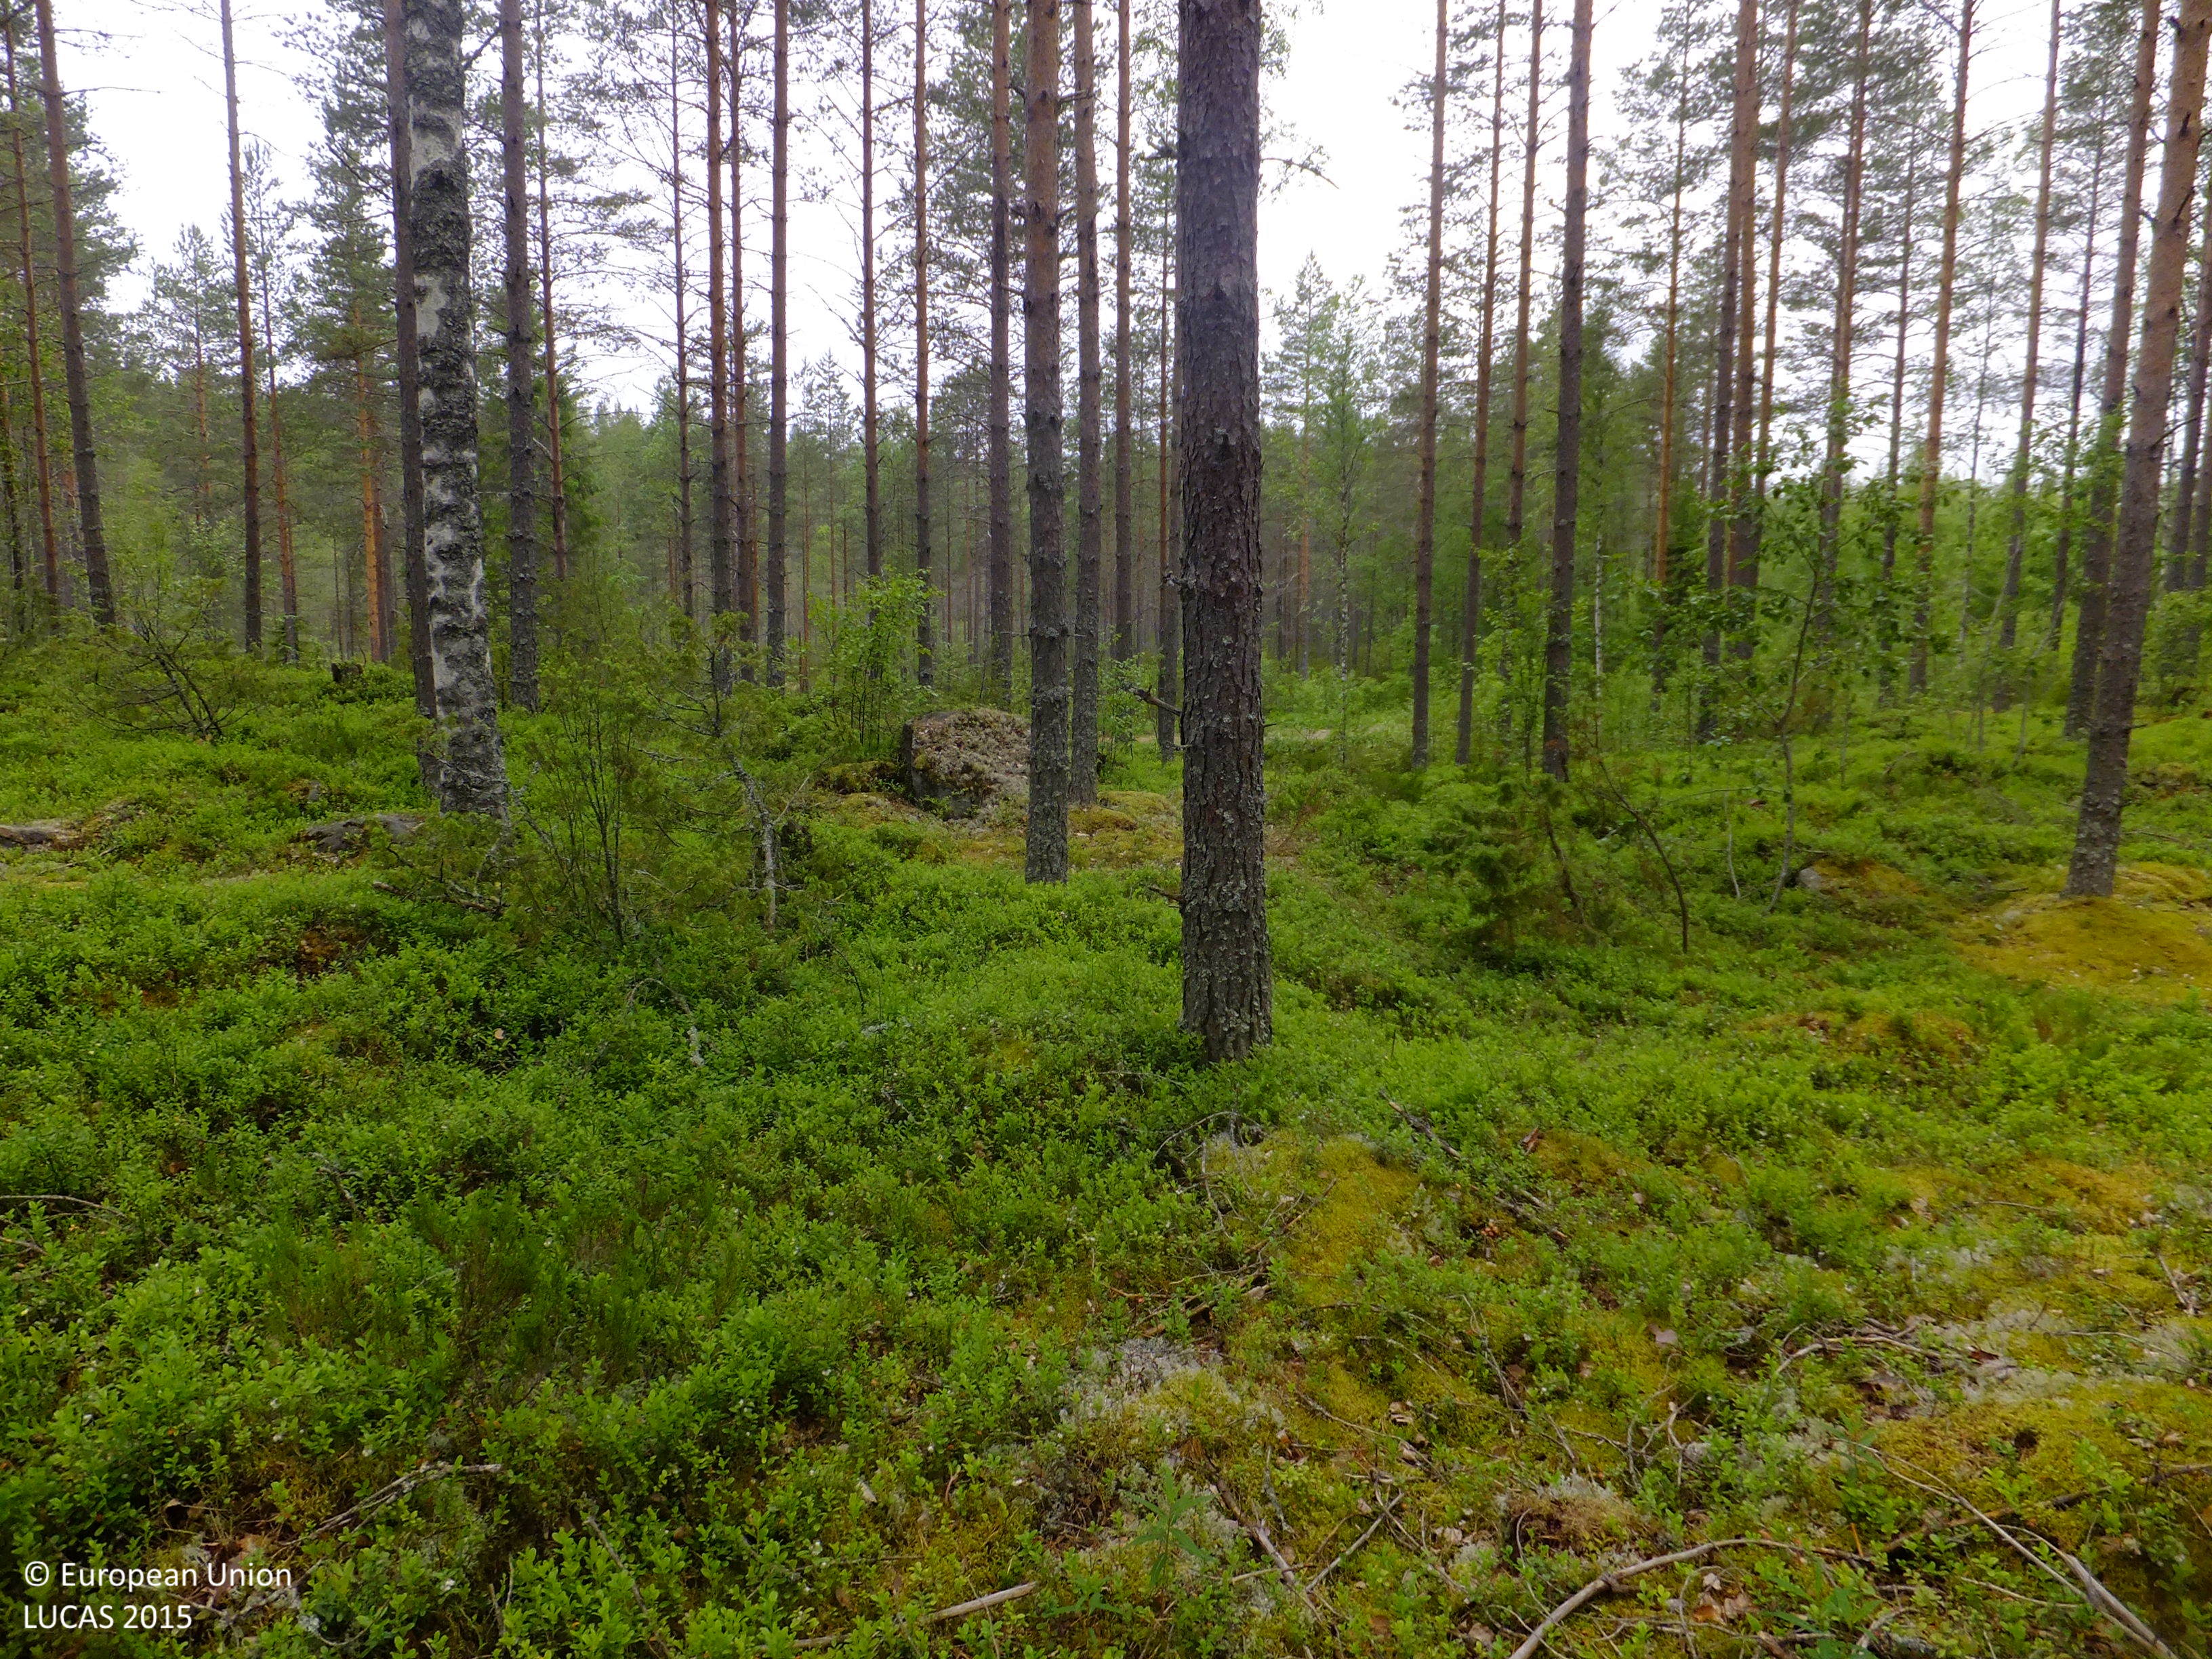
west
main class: Woodland
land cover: Pine dominated coniferous woodland
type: boreal forest
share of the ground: 50 - 75 %
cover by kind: coniferous forest trees 60 %, shrubs 20 %, lichens and mosses 15 %, broadleaved forest trees 5 %
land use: Forestry
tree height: > 5 m
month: July
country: FI
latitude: 63.1289
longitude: 24.7843
